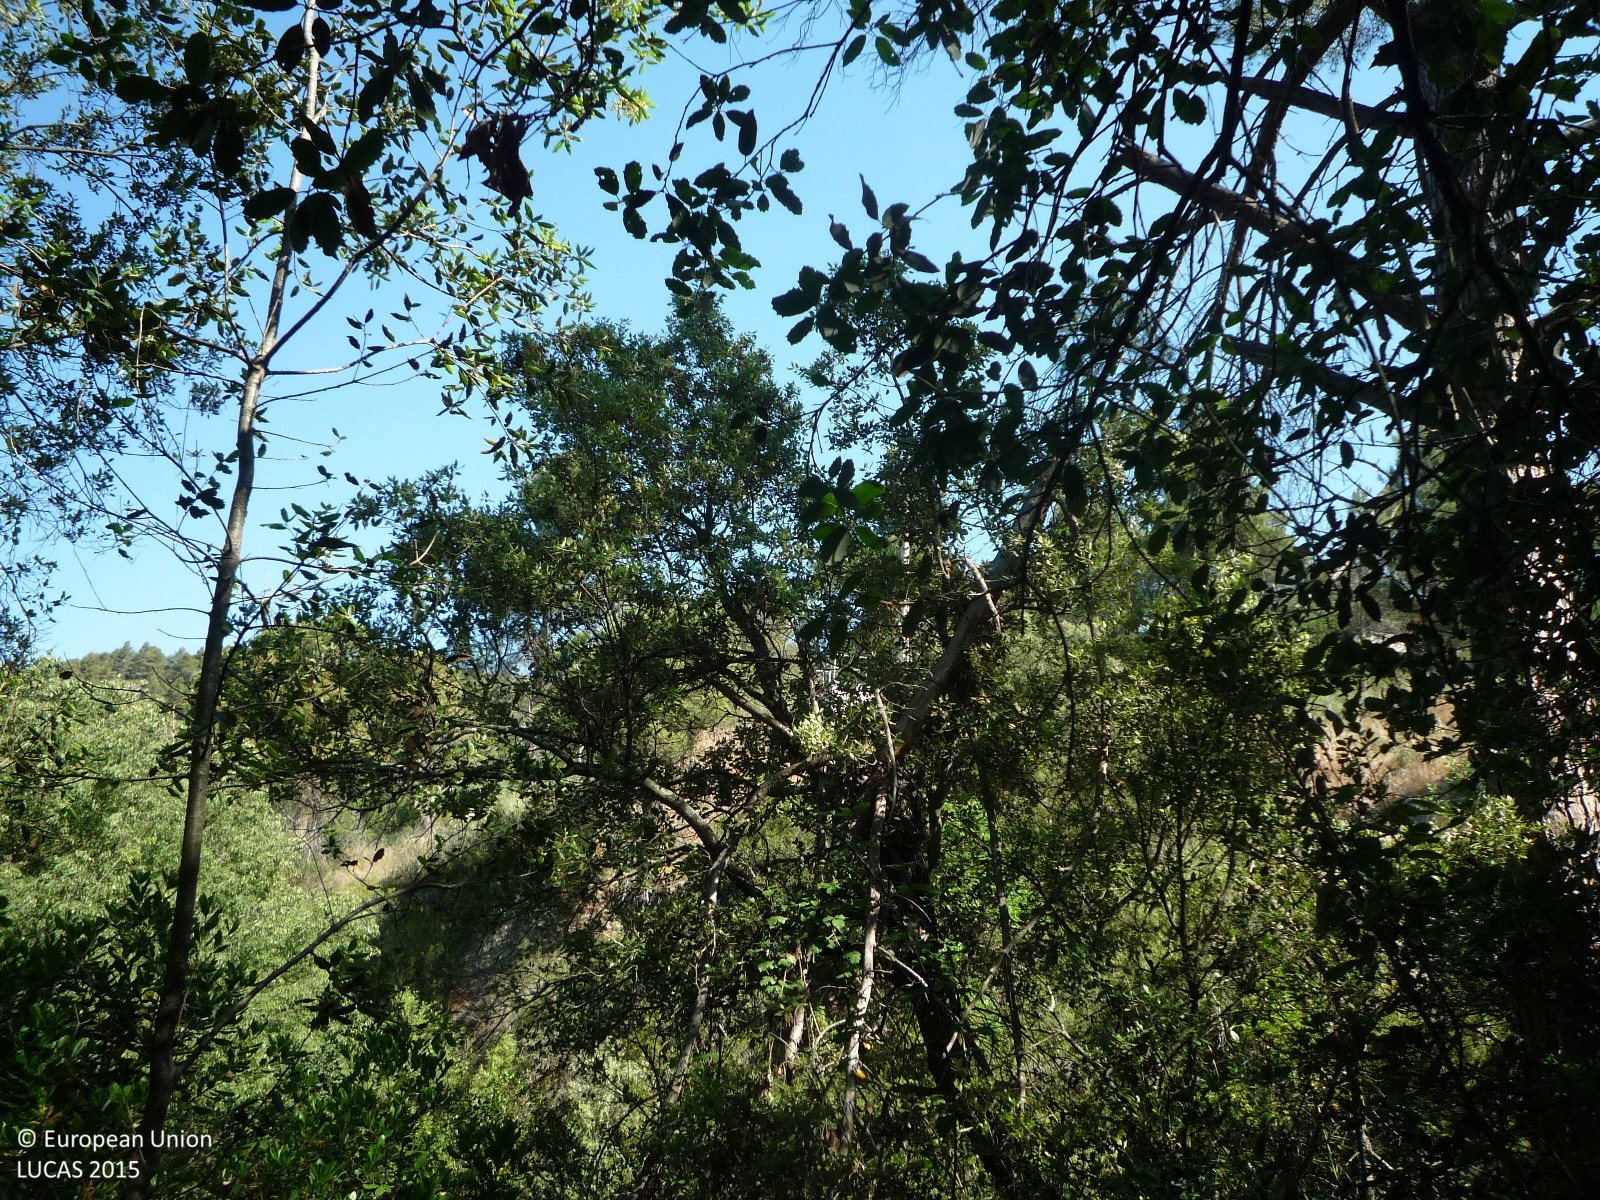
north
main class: Woodland
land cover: Other mixed woodland
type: broadleaved evergreen forest
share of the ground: > 75 %
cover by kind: broadleaved forest trees 50 %, coniferous forest trees 25 %, shrubs 25 %
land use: Semi-natural and natural areas not in use
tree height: > 5 m
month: June
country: ES
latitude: 41.7362
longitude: 1.9719
